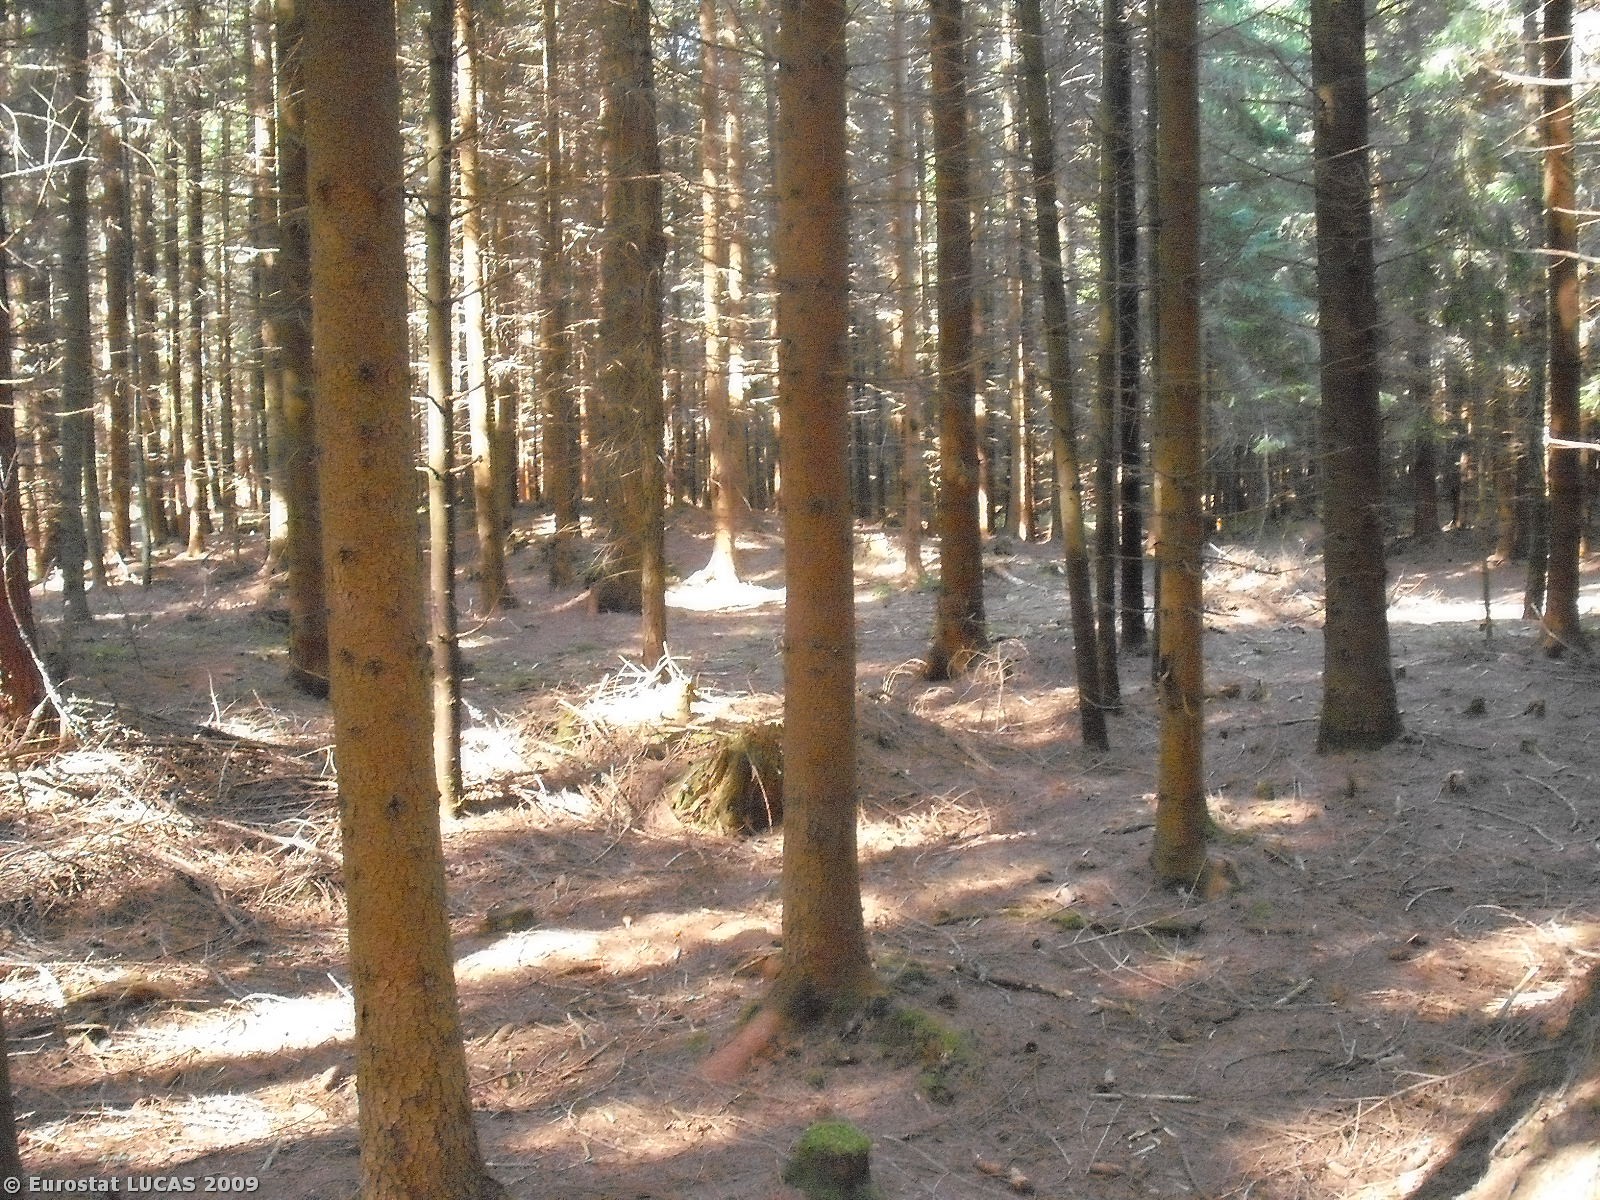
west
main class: Woodland
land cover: Coniferous woodland
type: hemiboreal forest and nemoral coniferous forest and mixed broadleaved-coniferous forest
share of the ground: > 75 %
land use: Forestry
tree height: > 5 m
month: September
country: PL
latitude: 49.5083
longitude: 20.9664
